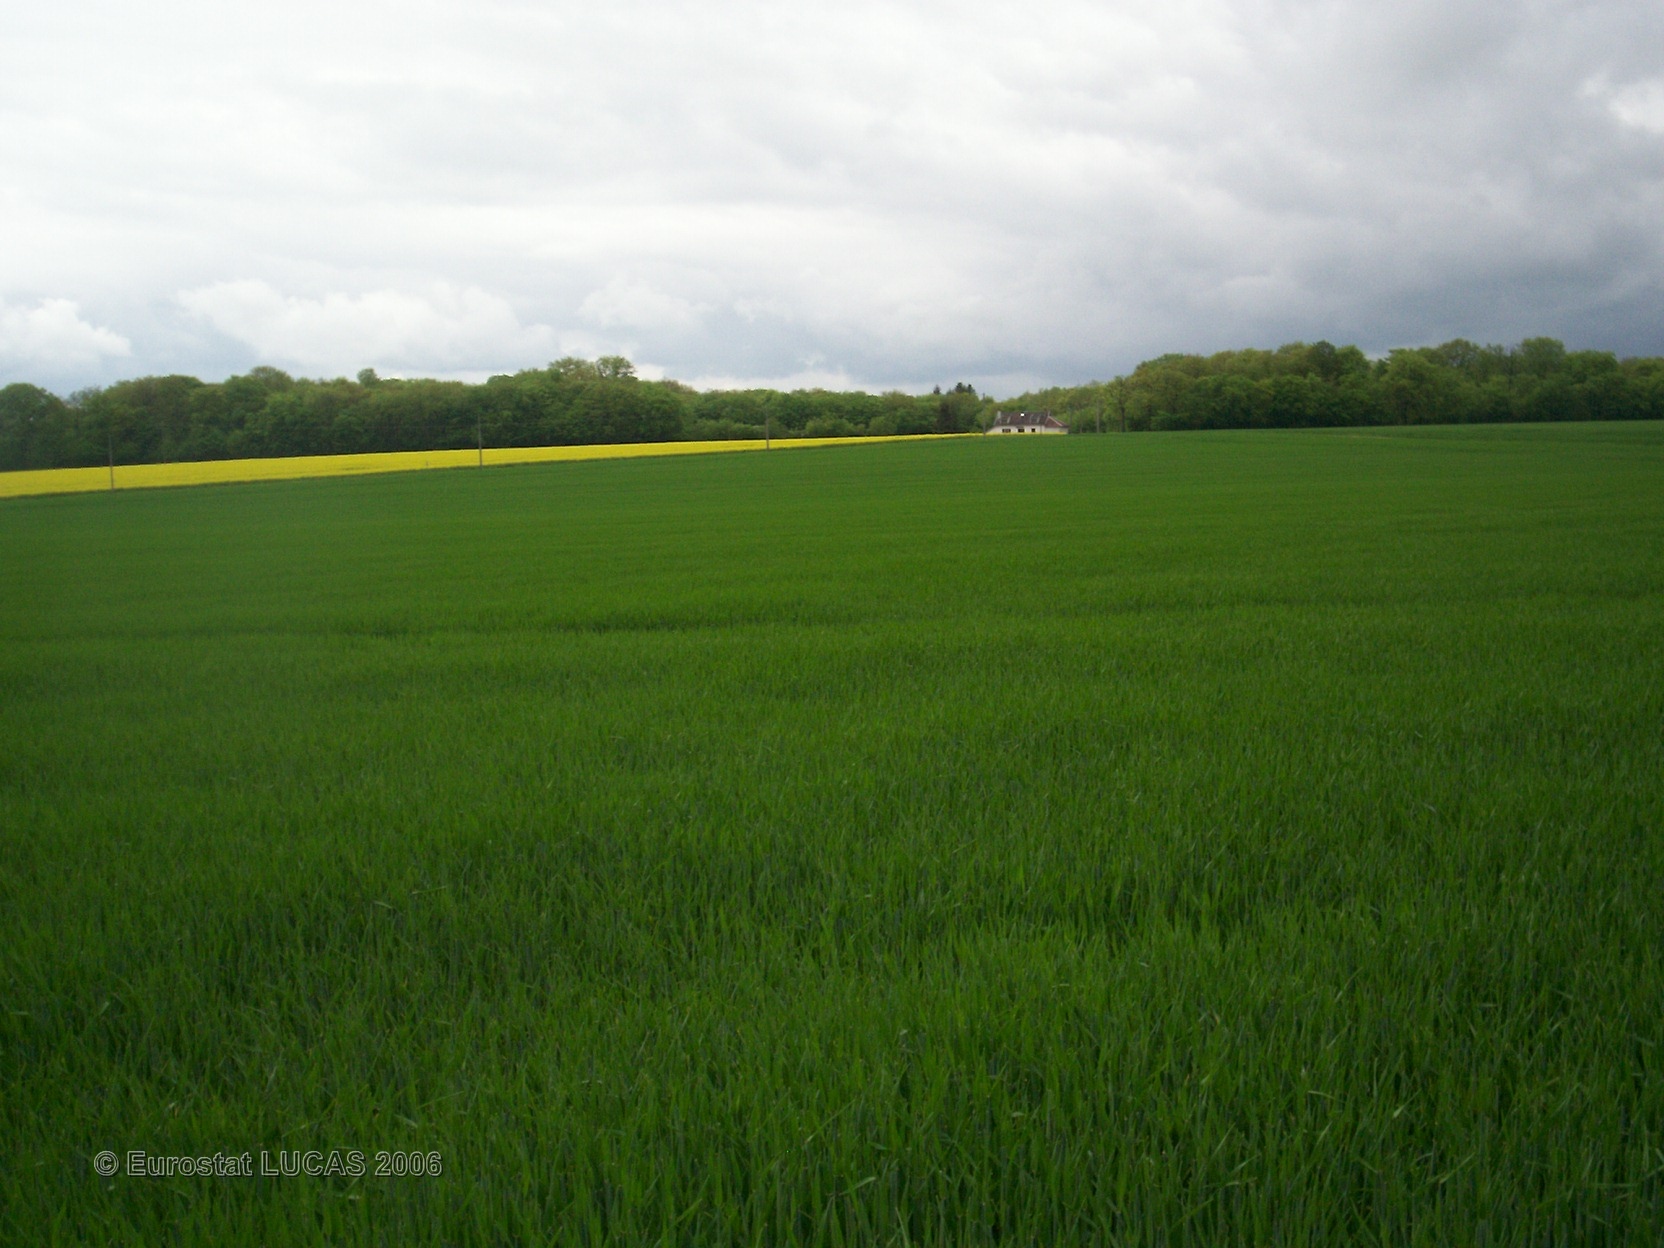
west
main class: Cropland
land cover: Barley
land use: Agriculture (excluding fallow land and kitchen gardens)
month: May
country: FR
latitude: 47.7677
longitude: 4.6216
